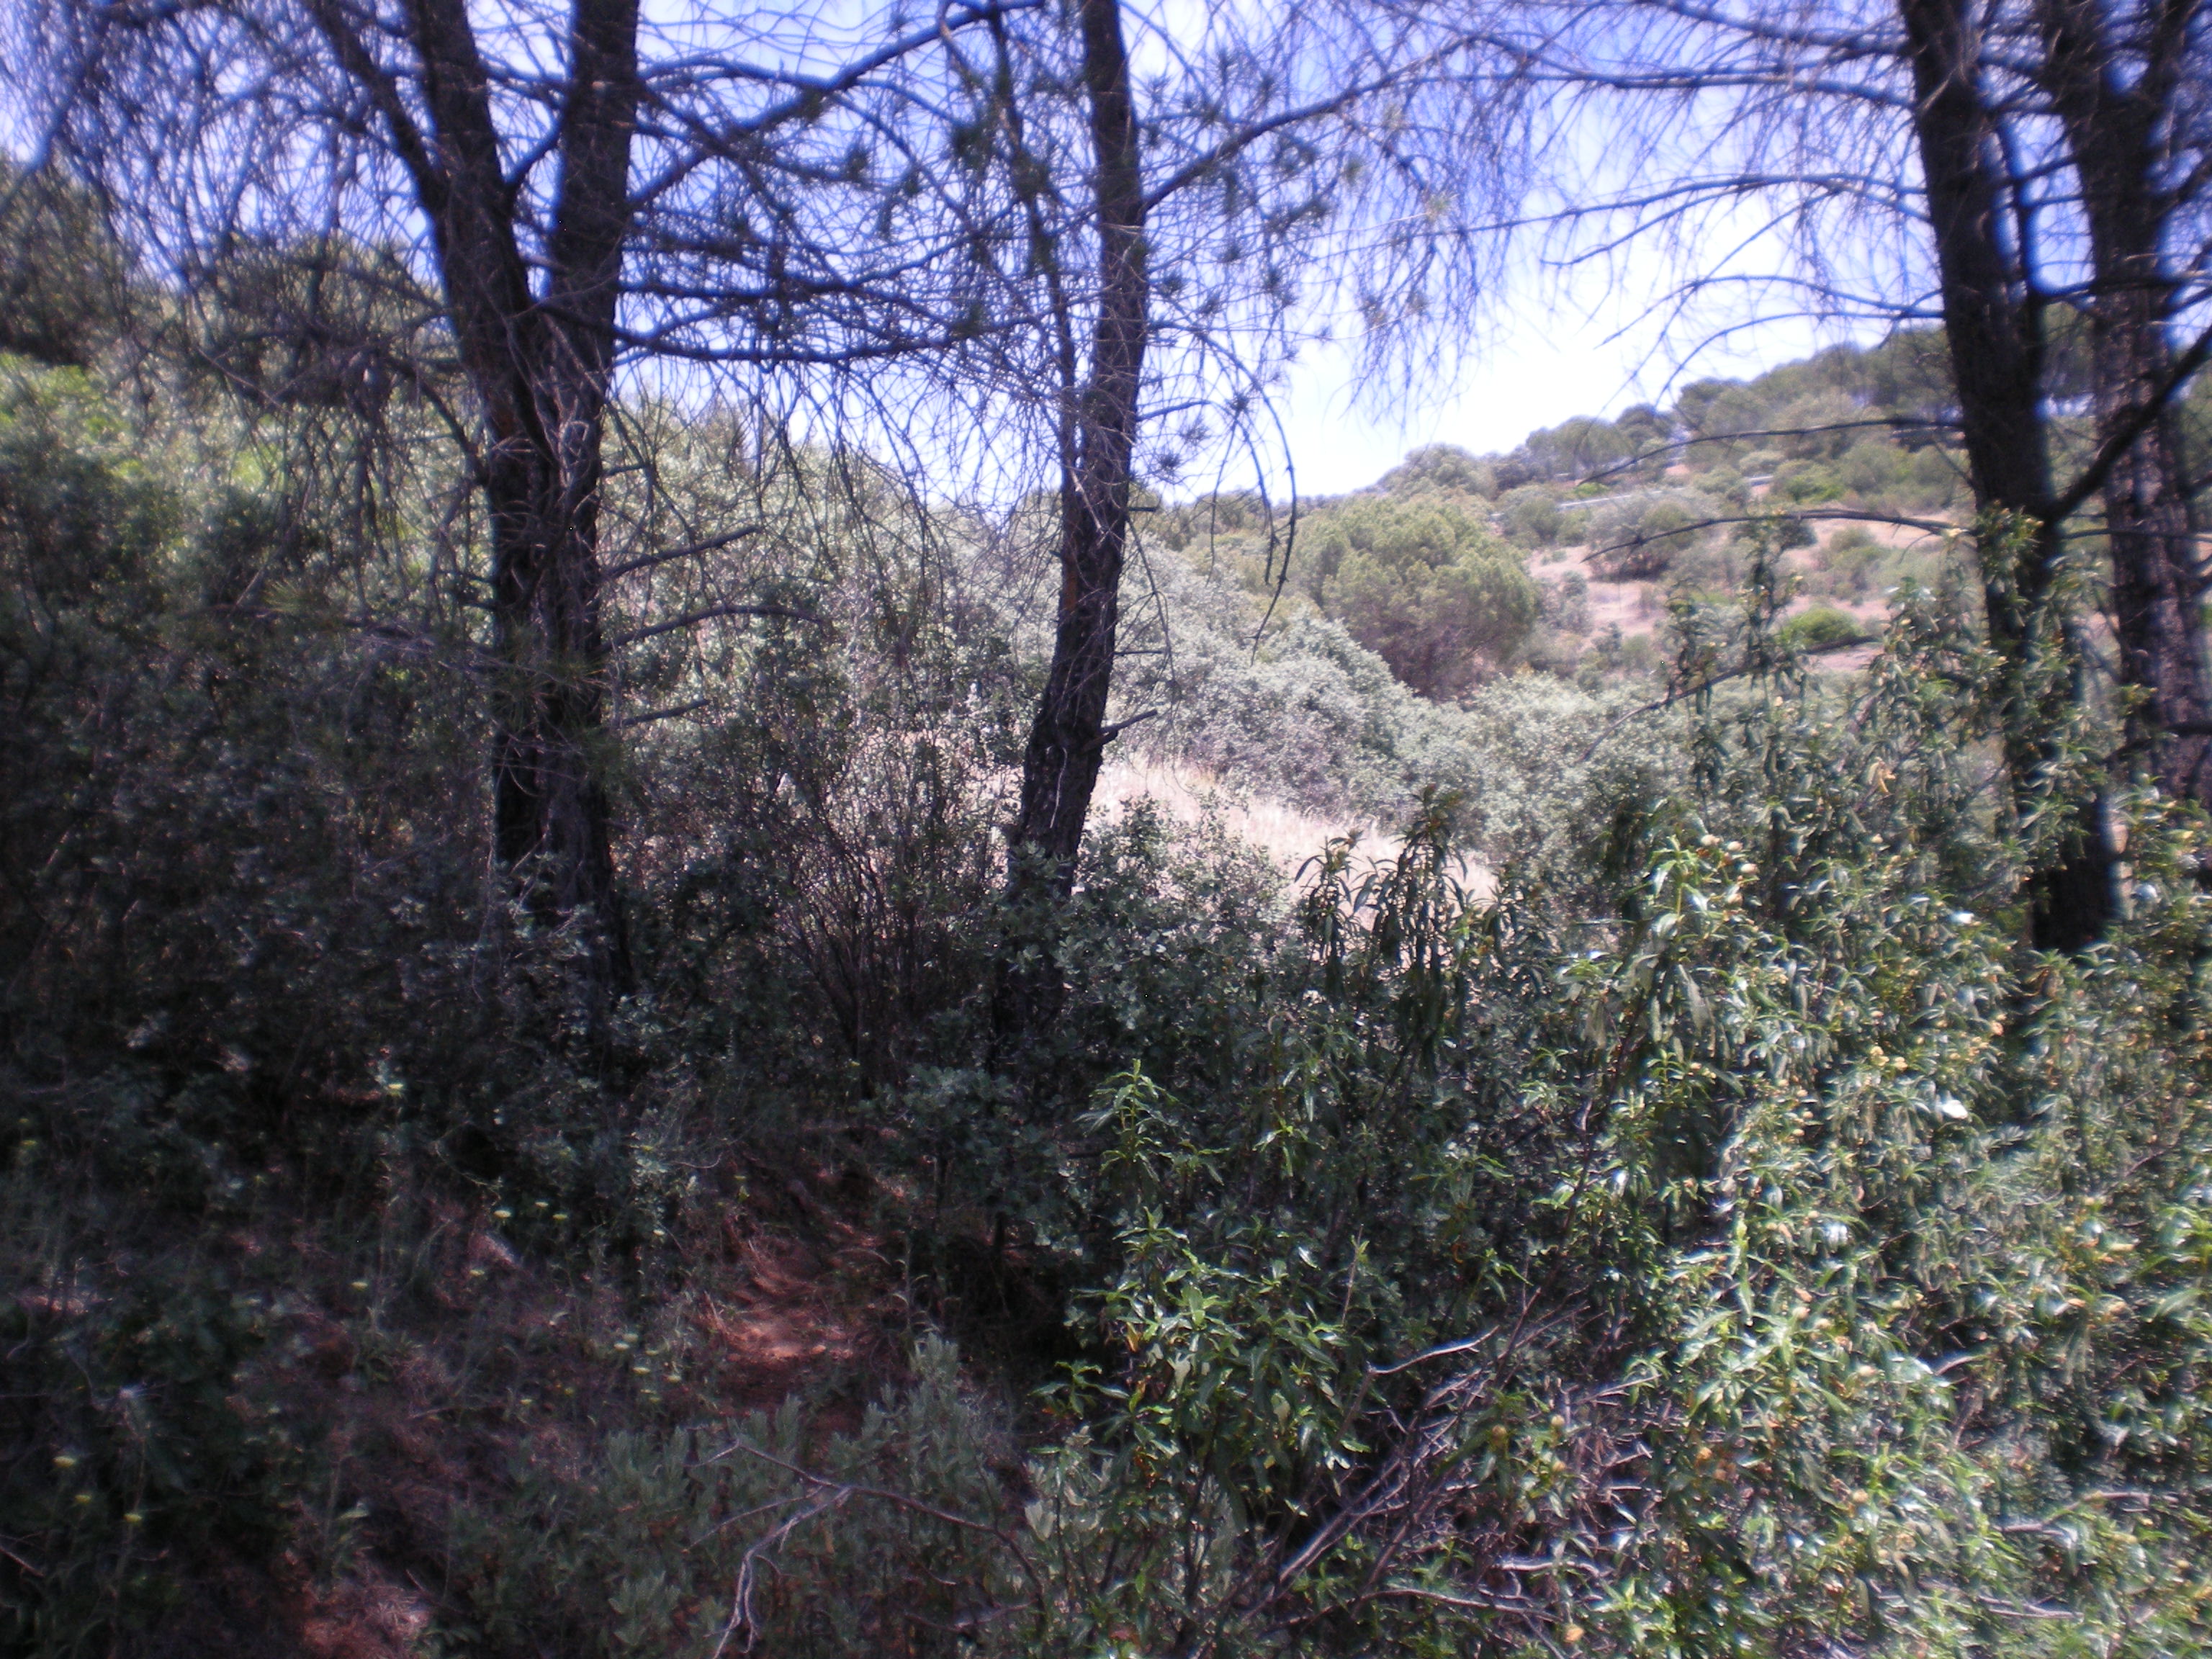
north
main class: Woodland
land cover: Pine dominated coniferous woodland
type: coniferous forest of the mediterranean region
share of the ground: 50 - 75 %
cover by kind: coniferous forest trees 30 %, shrubs 30 %, unconsolidated bare surface 25 %, herbaceous plants 10 %, broadleaved forest trees 5 %
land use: Semi-natural and natural areas not in use
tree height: > 5 m
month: May
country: ES
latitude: 38.3761
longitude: -3.5024
